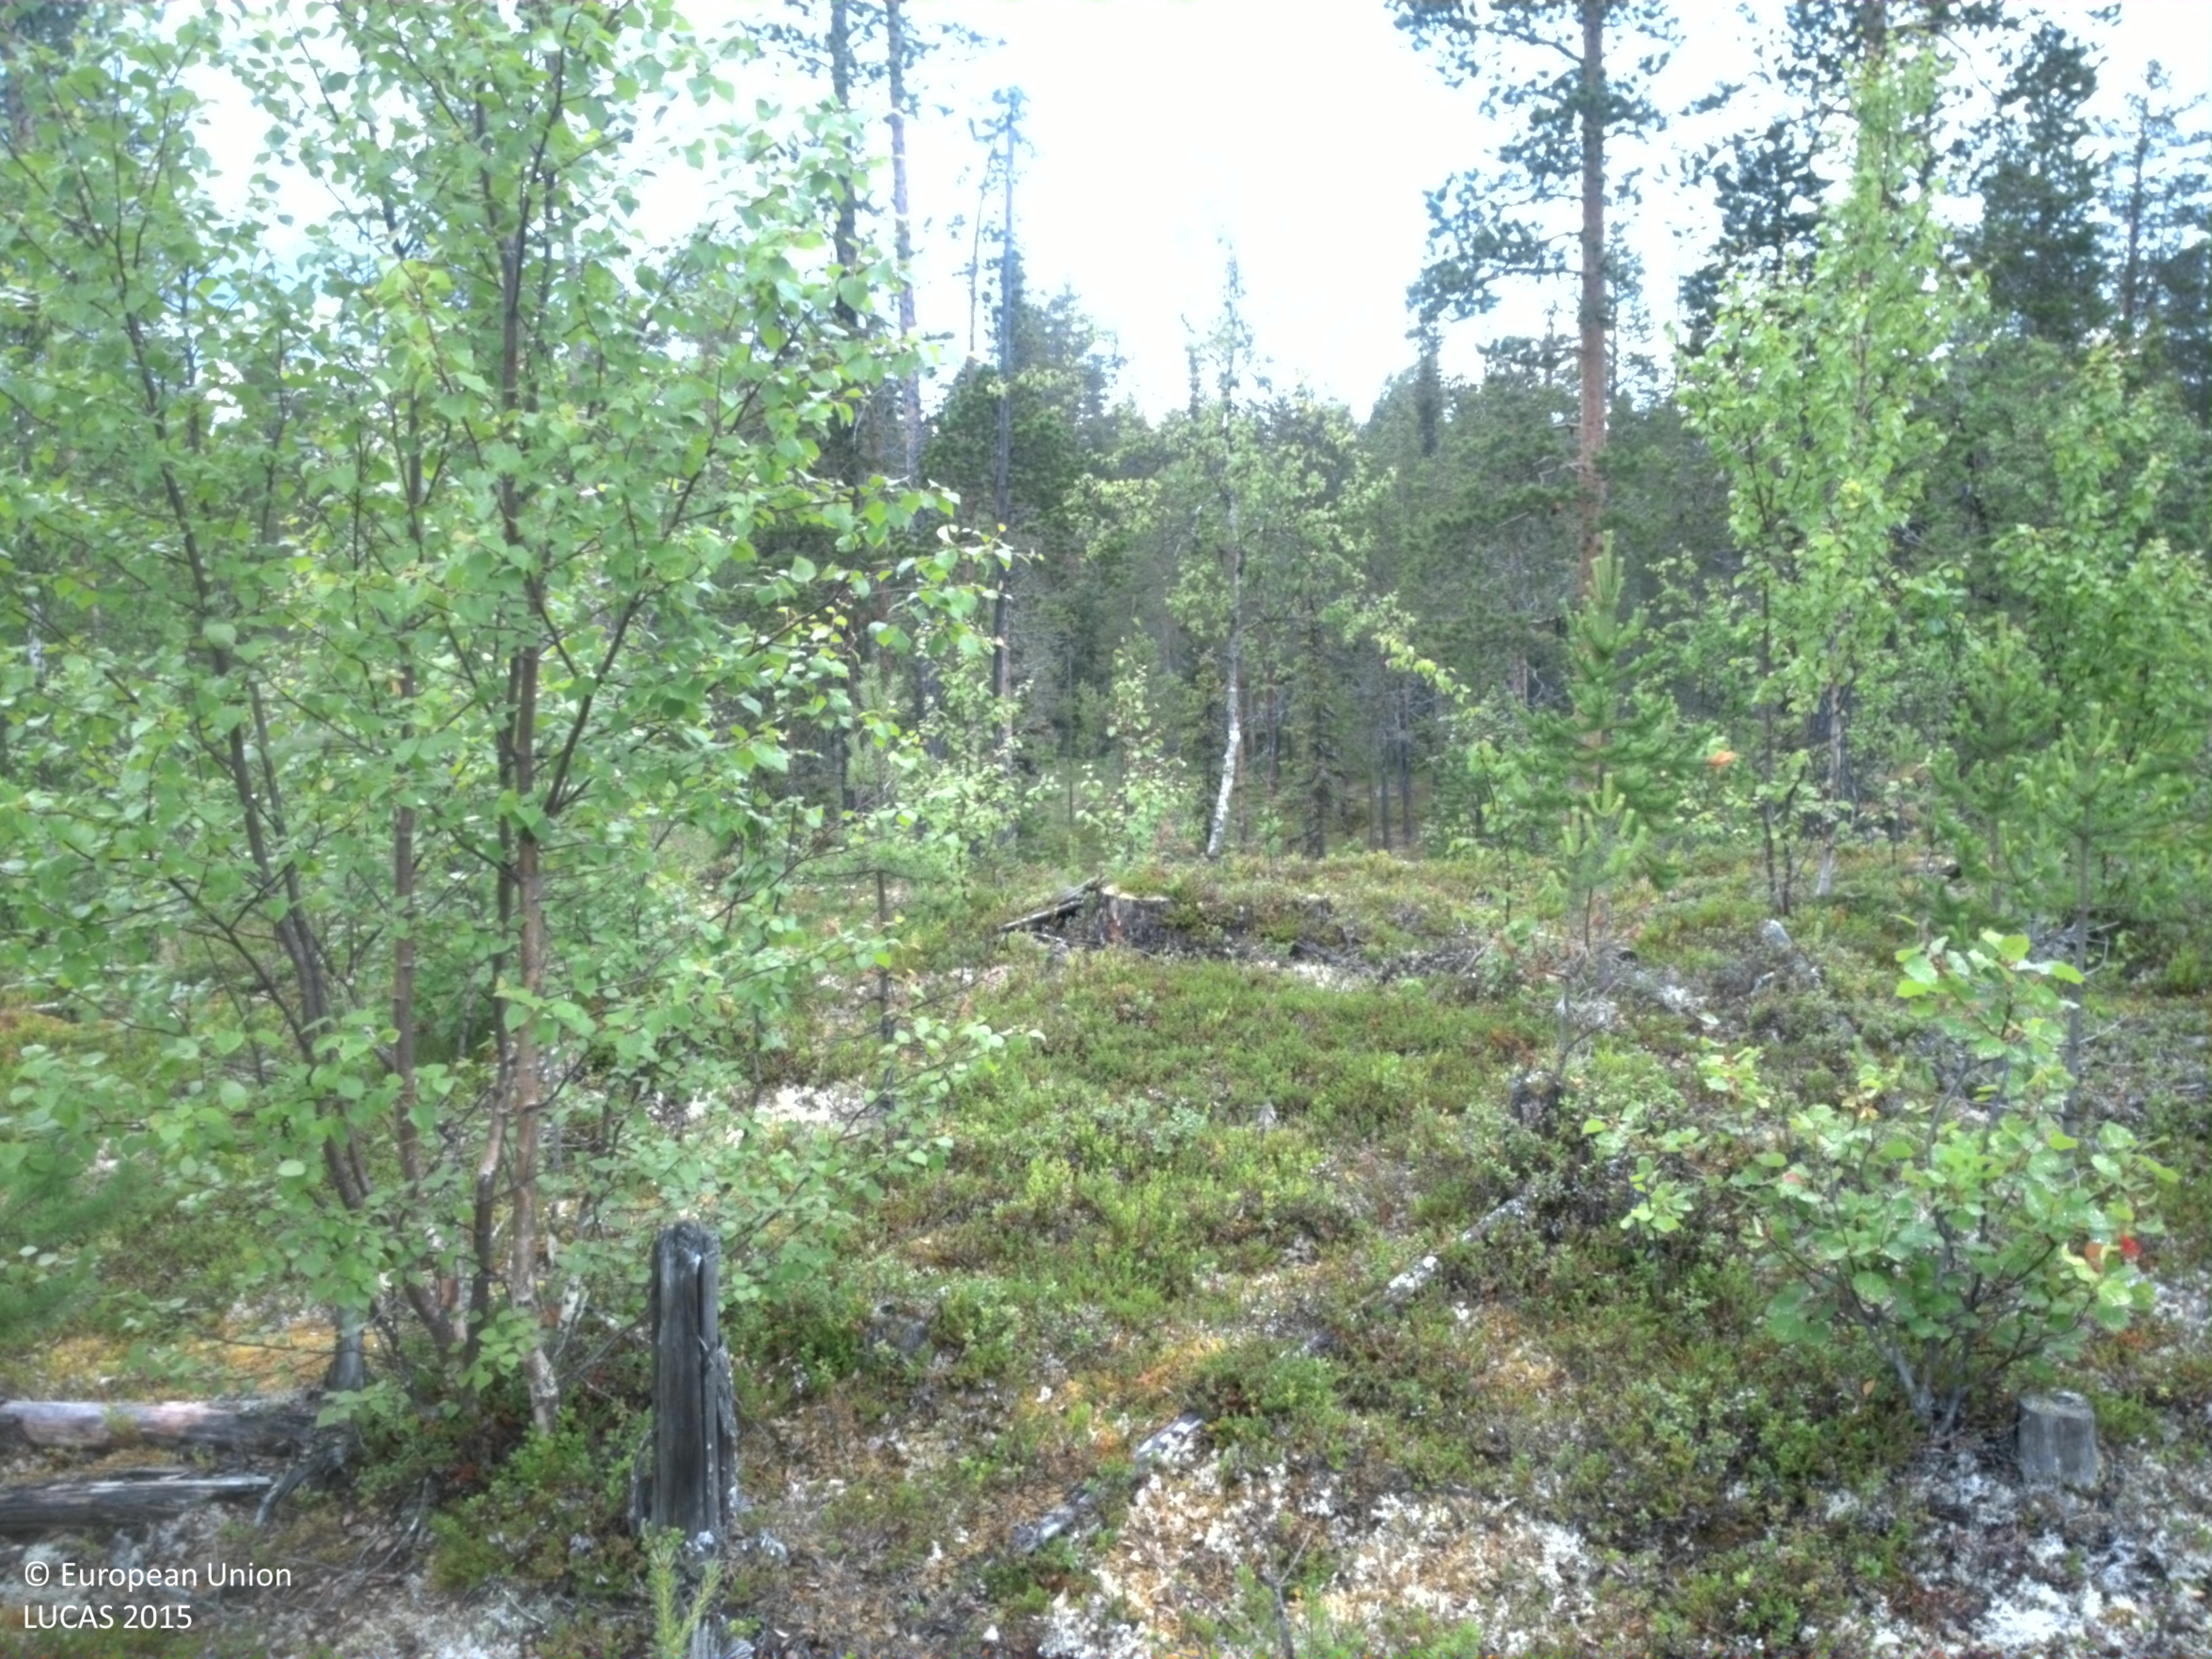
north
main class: Woodland
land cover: Pine dominated mixed woodland
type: boreal forest
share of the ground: 25 - 50 %
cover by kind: shrubs 60 %, coniferous forest trees 20 %, broadleaved forest trees 10 %, lichens and mosses 10 %
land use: Forestry
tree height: < 5 m
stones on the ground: 10 - 25 %
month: July
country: SE
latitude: 66.4092
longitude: 19.5151
